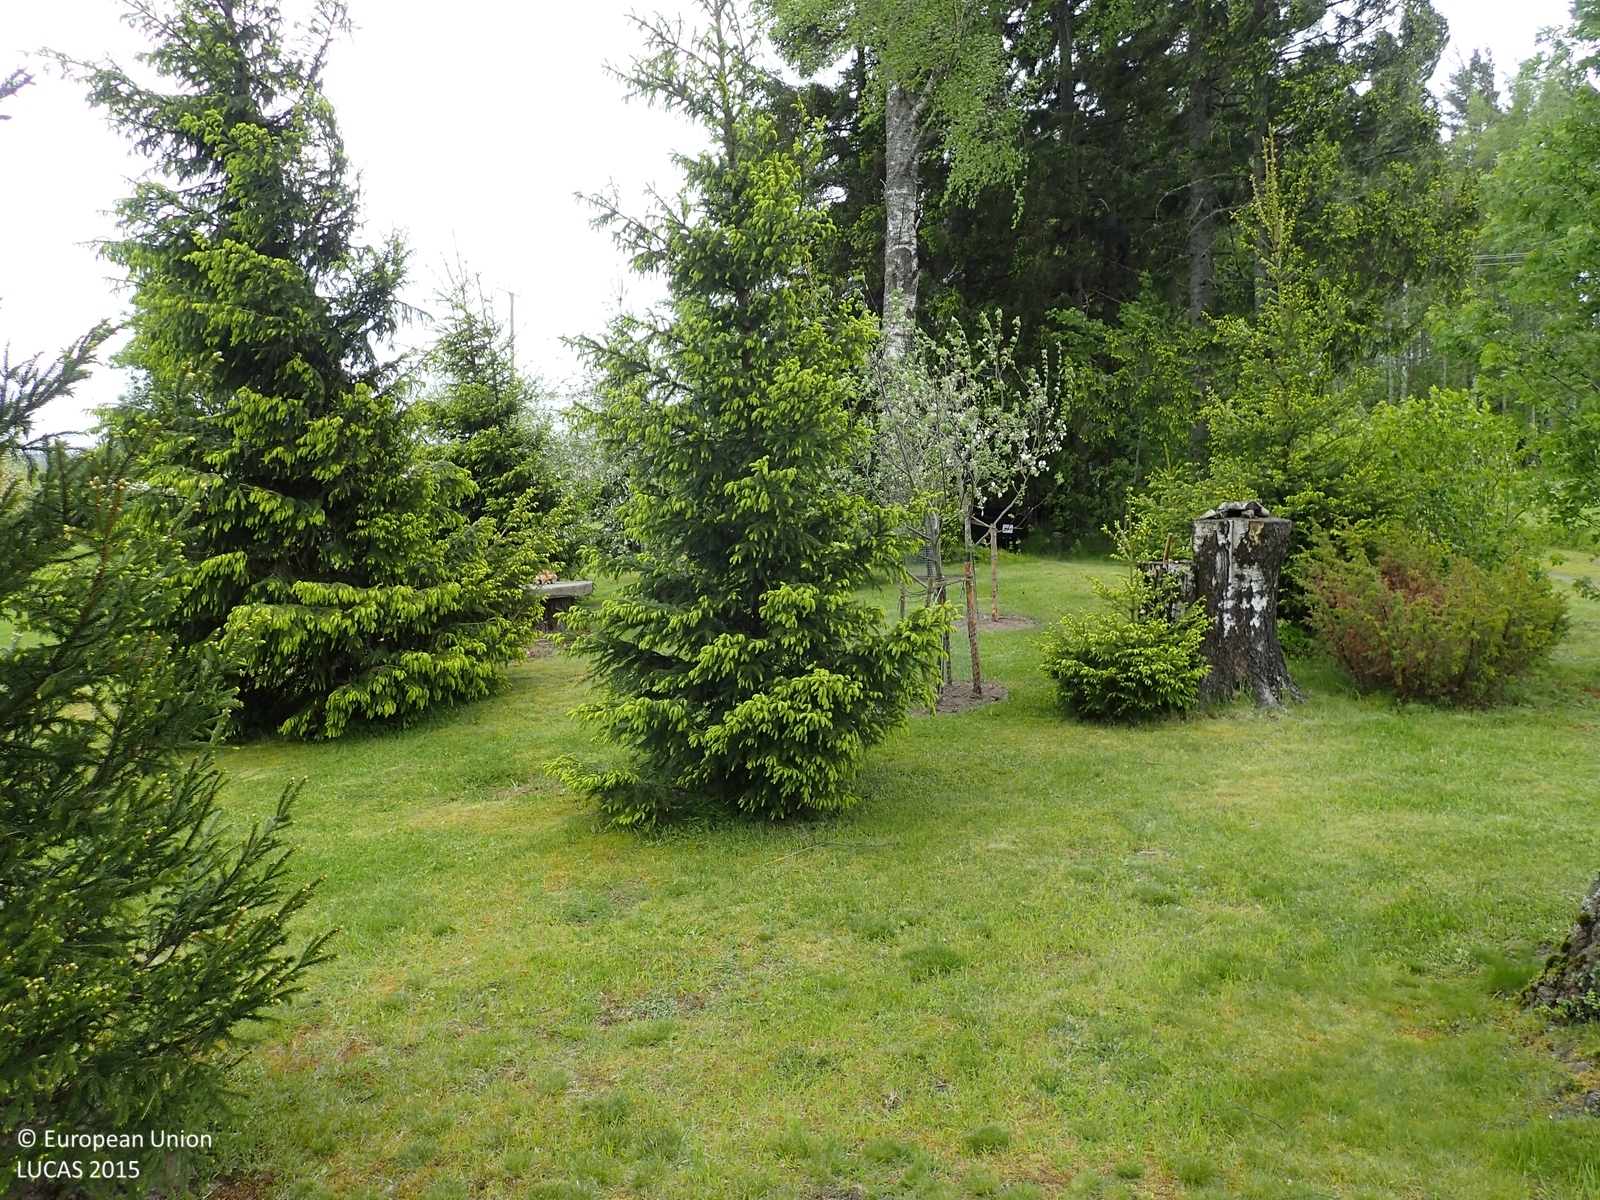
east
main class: Woodland
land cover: Spruce dominated mixed woodland
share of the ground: 10 - 25 %
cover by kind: herbaceous plants 65 %, coniferous forest trees 5 %, broadleaved forest trees 5 %
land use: Residential
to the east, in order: Spruce dominated mixed woodland; Strawberries; Electric lines; Temporary grasslands
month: June
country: FI
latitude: 62.2672
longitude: 21.6623
